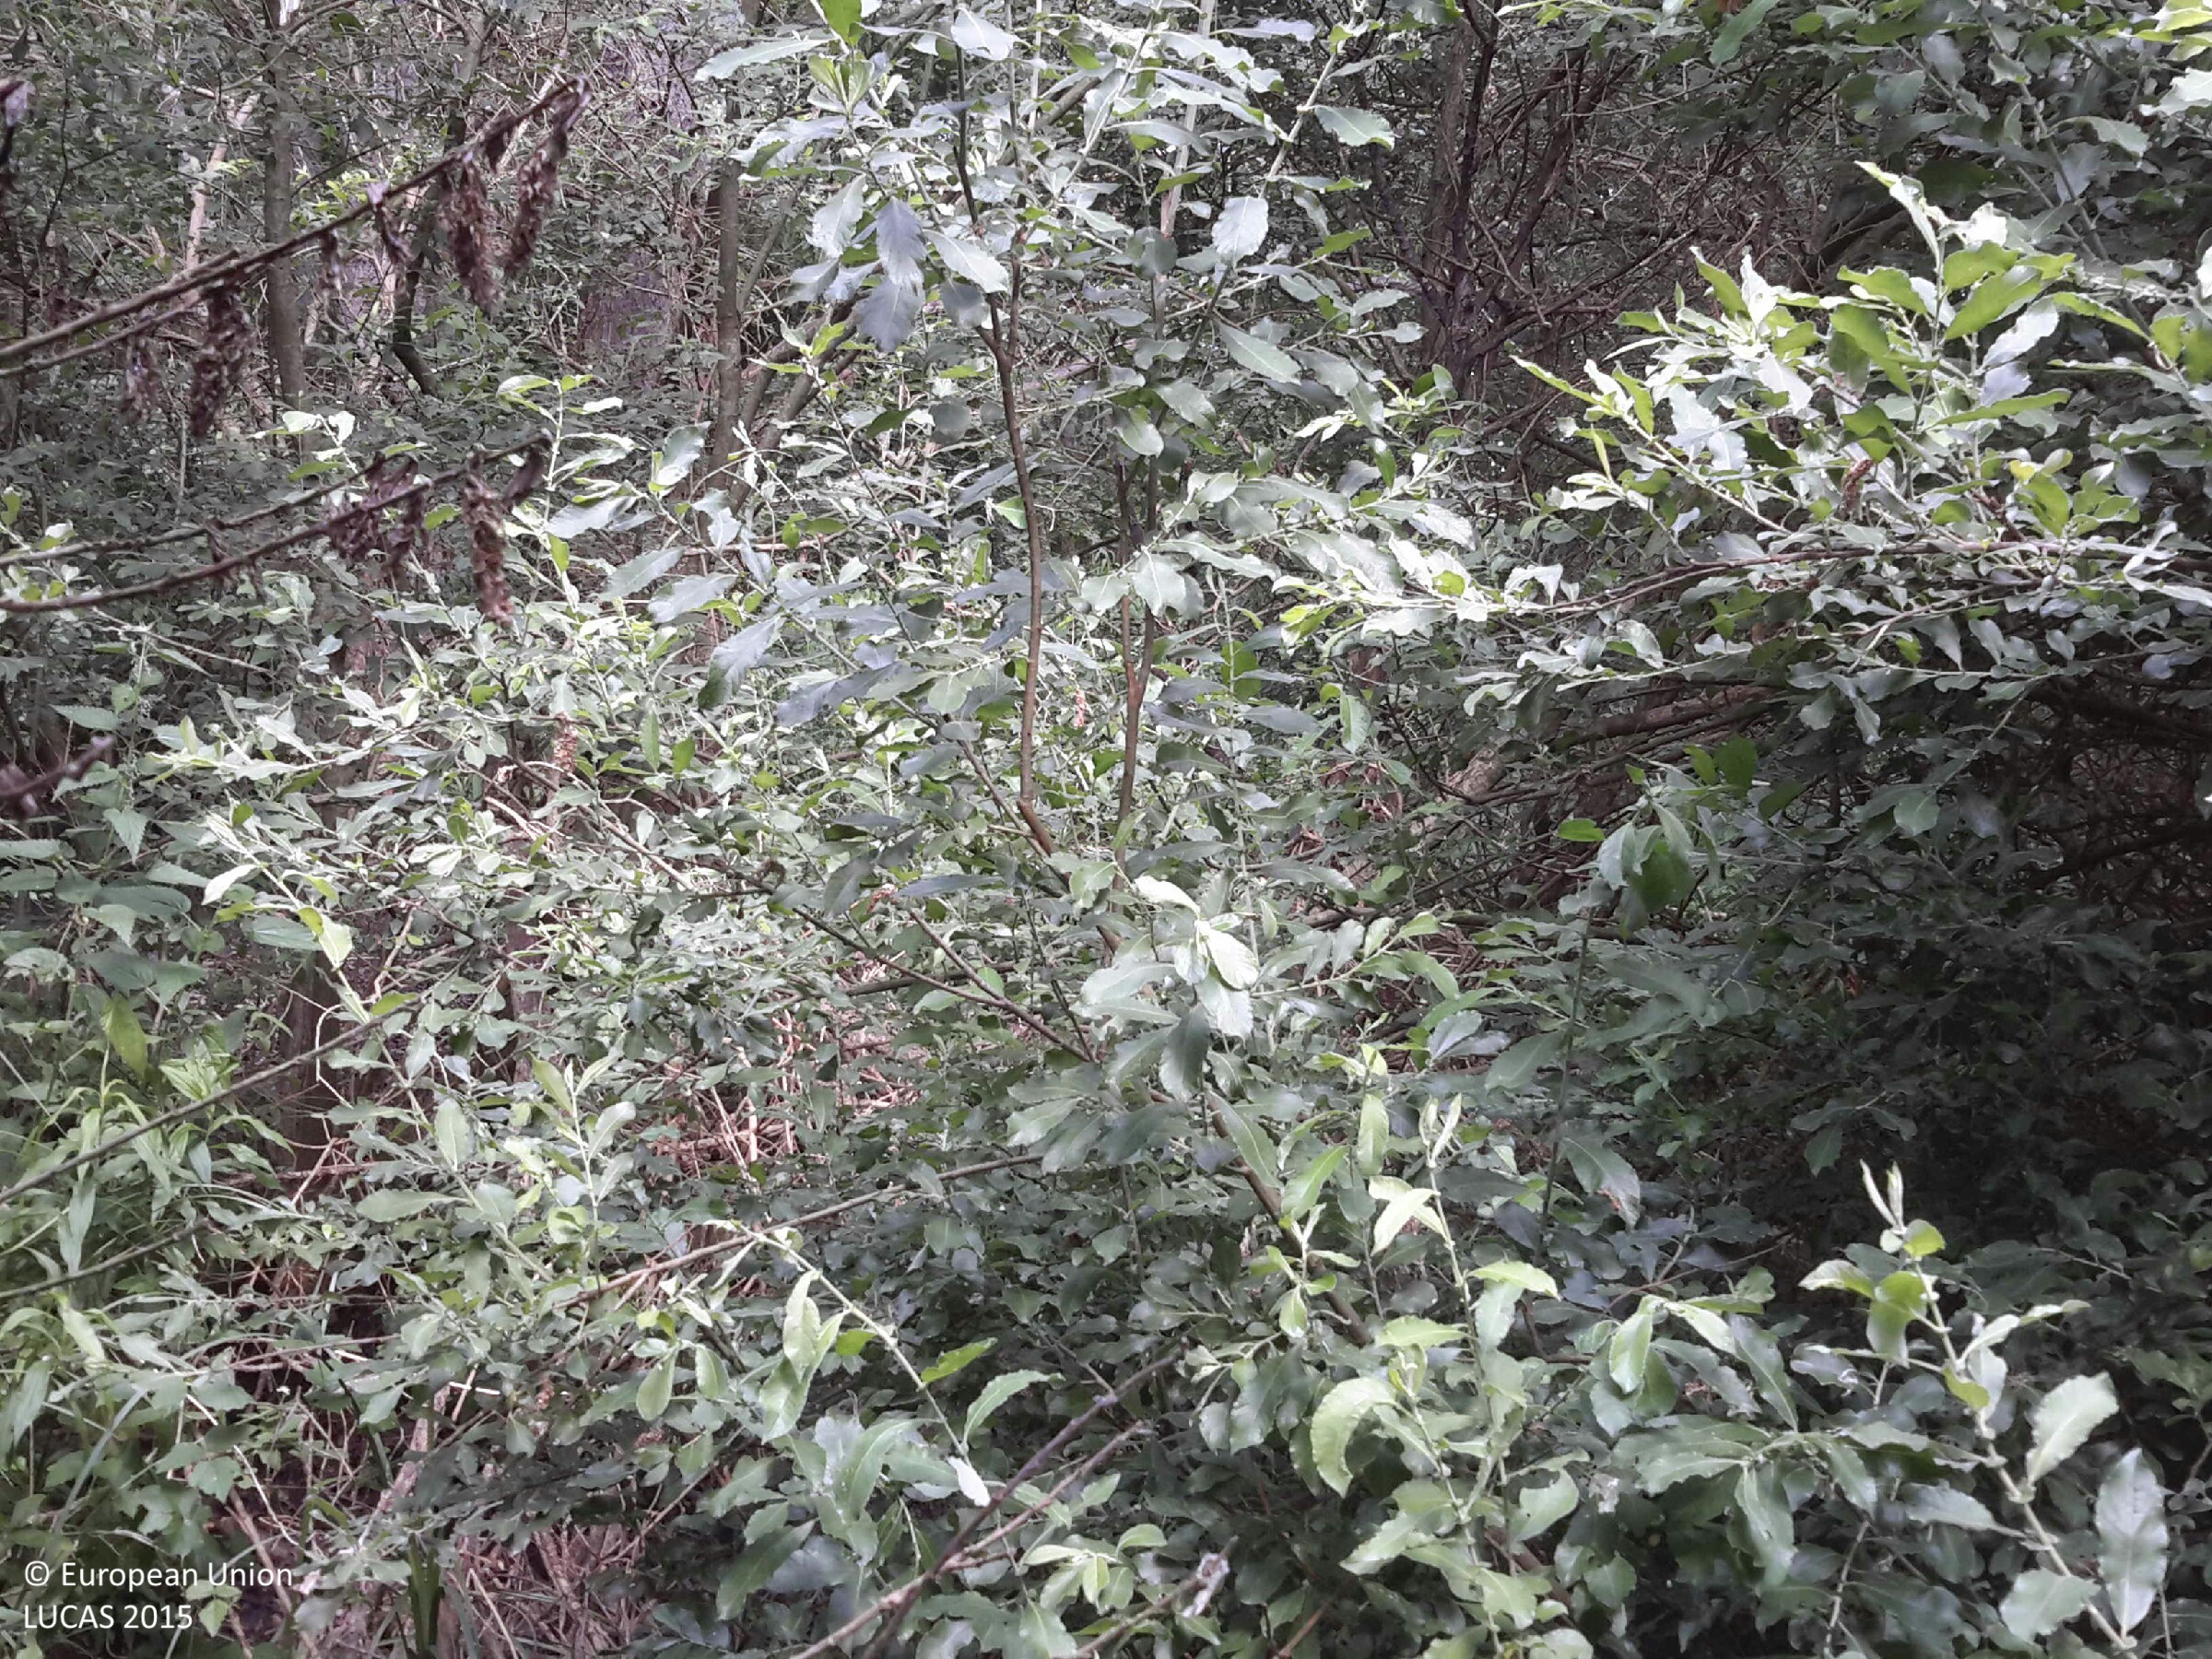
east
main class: Shrubland
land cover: Shrubland with sparse tree cover
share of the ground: > 75 %
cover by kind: shrubs 90 %, broadleaved forest trees 5 %, herbaceous plants 5 %
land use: Forestry
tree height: > 5 m
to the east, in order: Shrubland with sparse tree cover; Spontaneously vegetated surfaces; Broadleaved woodland; Ditches and canals; Broadleaved woodland; Ditches and canals; Broadleaved woodland; Tracks; Broadleaved woodland; Grassland with sparse tree/shrub cover; Grassland without tree/shrub cover; Broadleaved woodland
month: June
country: HU
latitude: 47.7176
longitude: 17.4601
